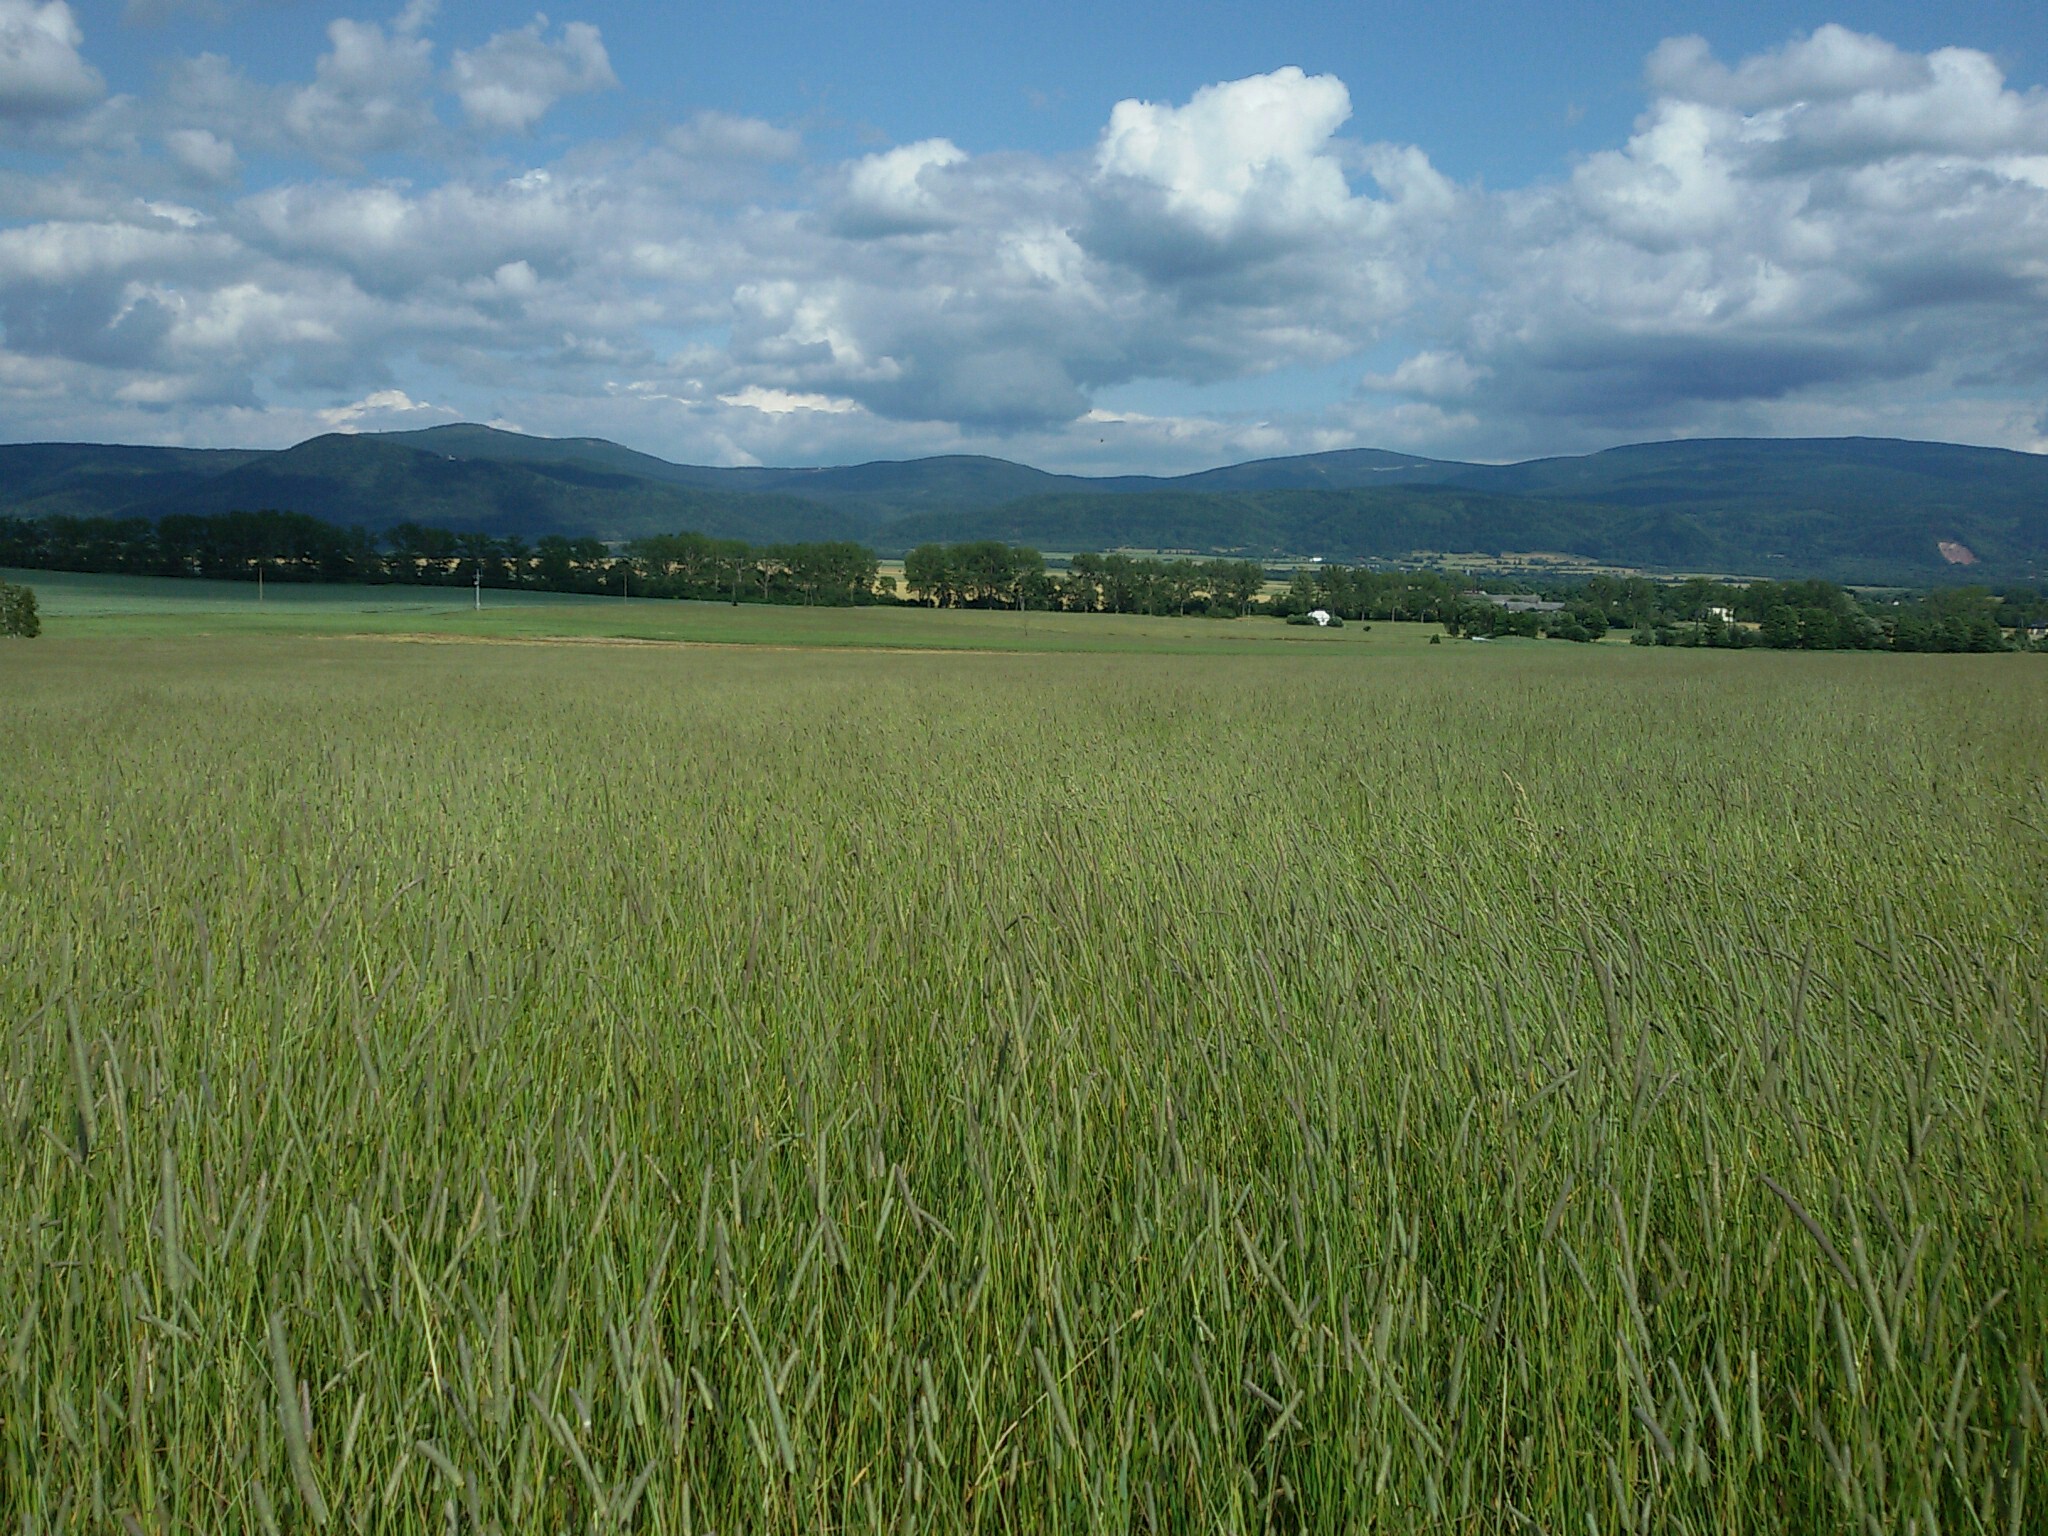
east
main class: Grassland
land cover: Grassland without tree/shrub cover
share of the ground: > 75 %
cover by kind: herbaceous plants 100 %
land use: Agriculture (excluding fallow land and kitchen gardens)
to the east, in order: Grassland without tree/shrub cover; Common wheat
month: July
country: PL
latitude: 50.2237
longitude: 16.6661
